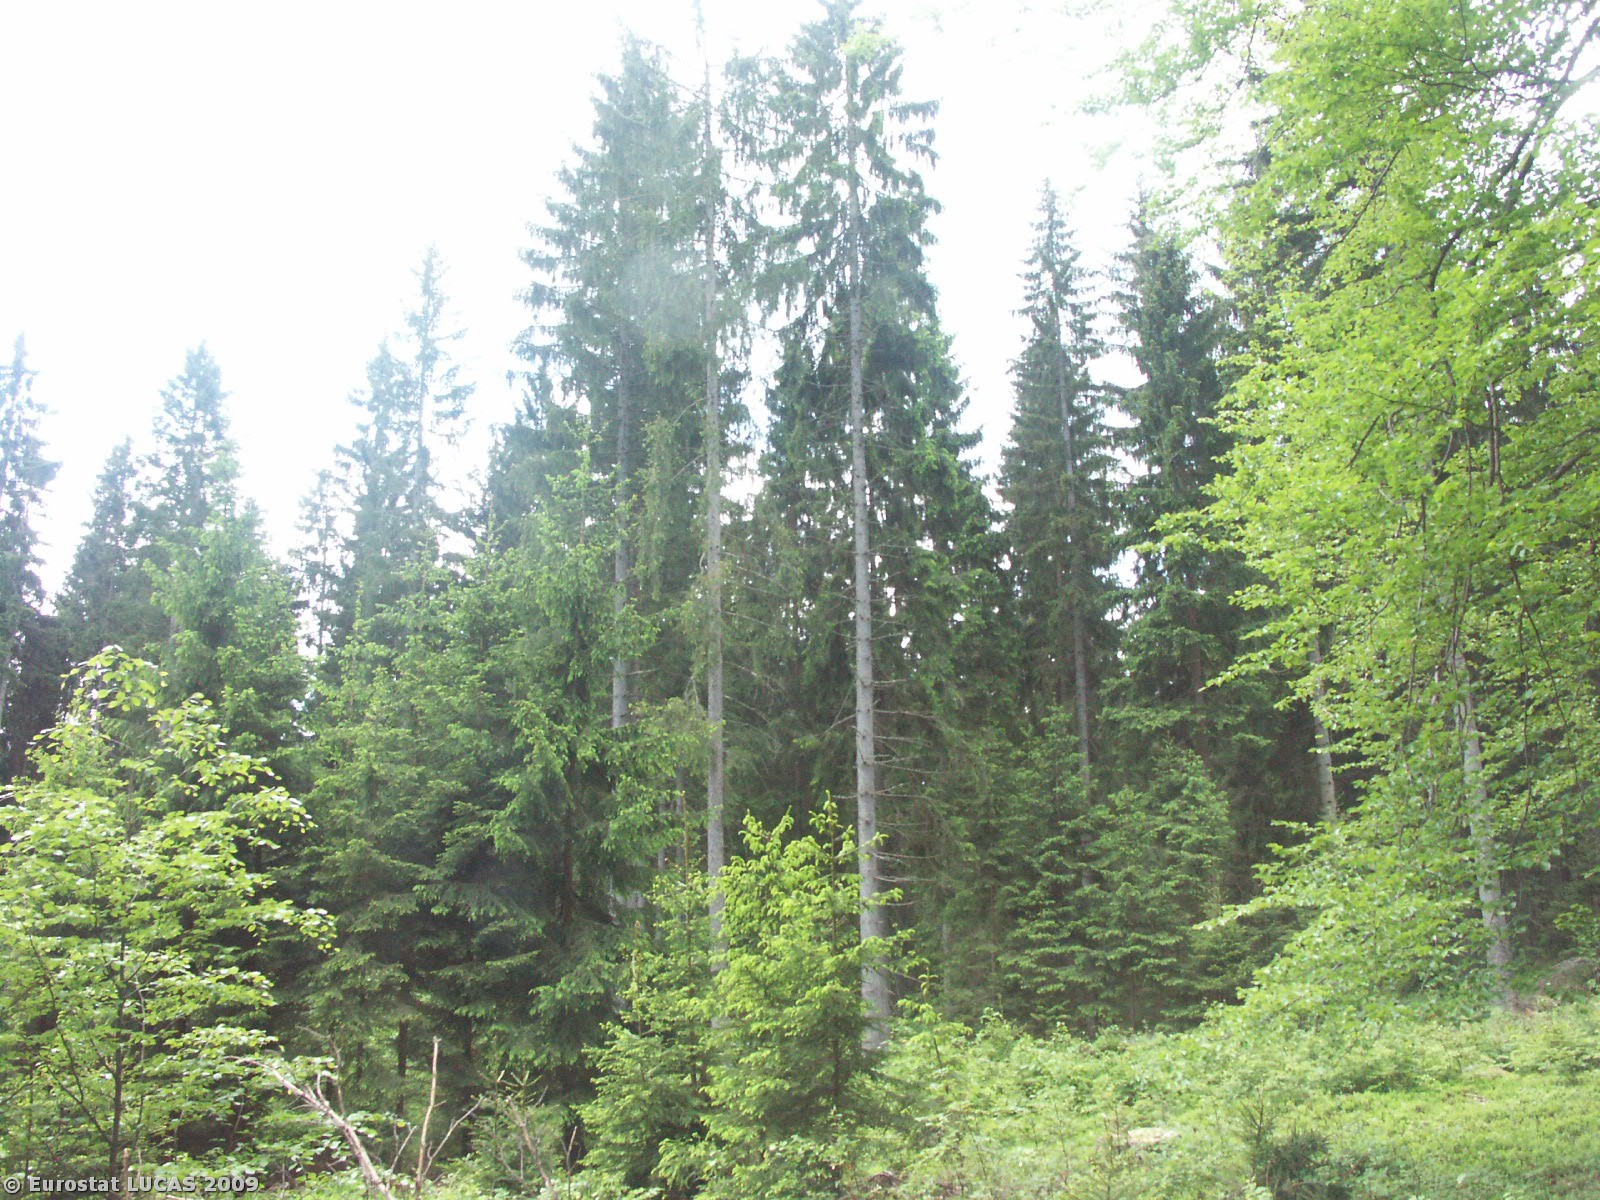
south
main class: Woodland
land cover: Mixed woodland
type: mountainous beech forest
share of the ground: > 75 %
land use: Forestry
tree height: > 5 m
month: May
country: CZ
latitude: 48.6838
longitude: 14.6601
